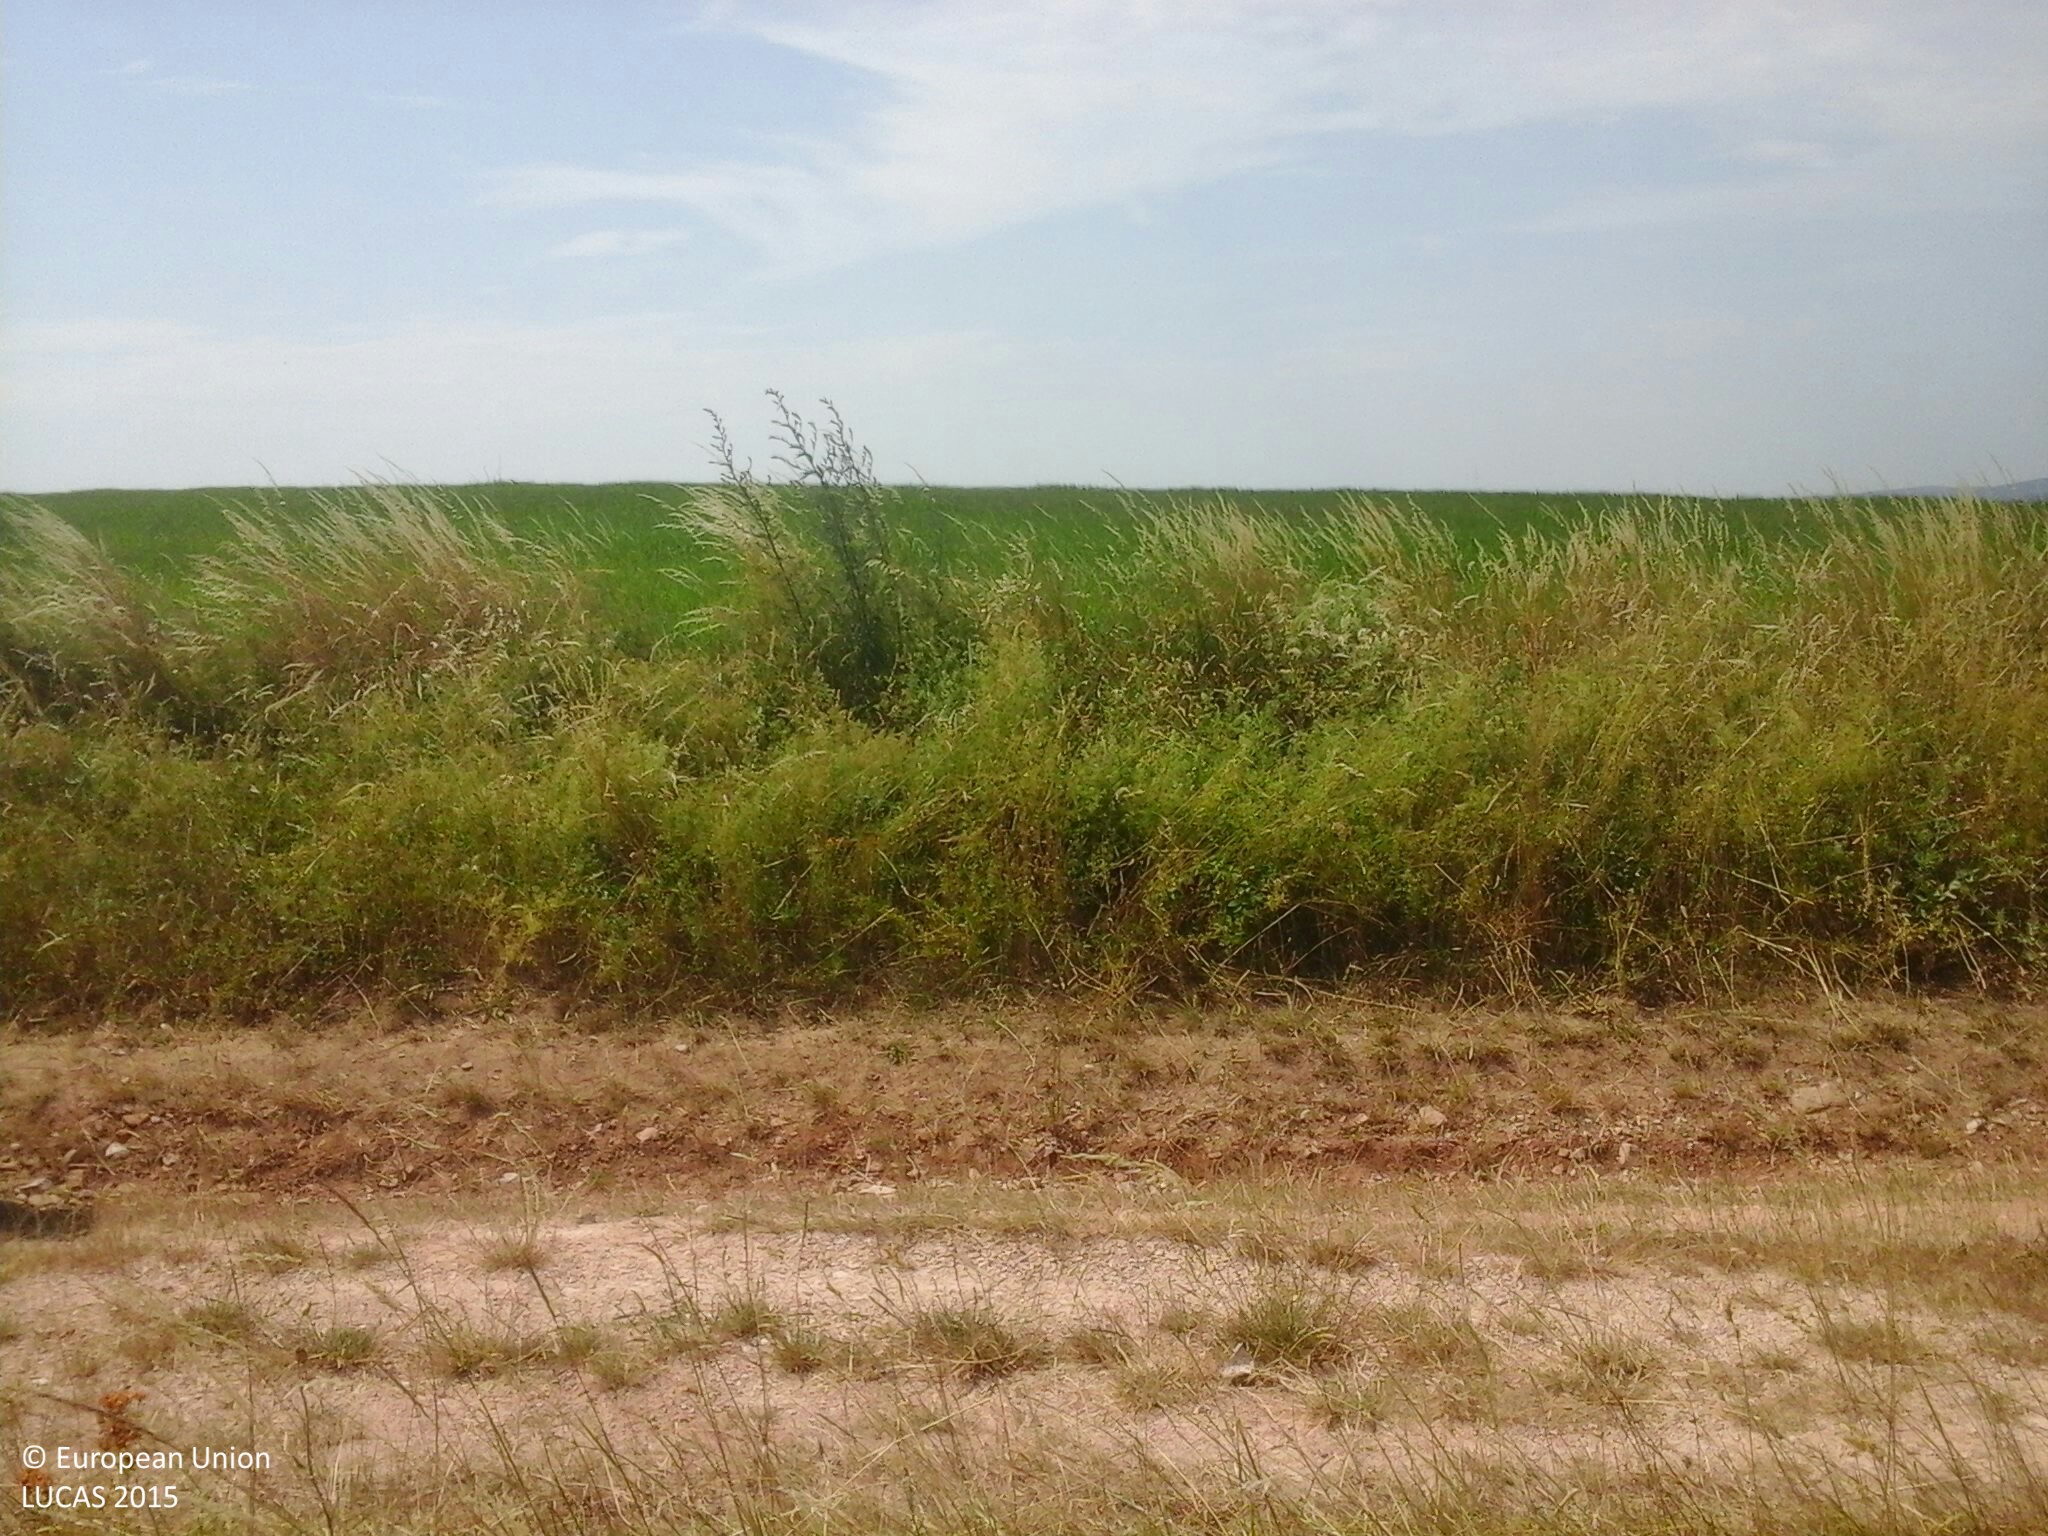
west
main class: Grassland
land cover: Grassland with sparse tree/shrub cover
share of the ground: > 75 %
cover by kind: herbaceous plants 90 %, broadleaved forest trees 5 %, shrubs 5 %
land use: Agriculture (excluding fallow land and kitchen gardens)
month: July
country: HU
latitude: 47.0062
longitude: 17.8076
